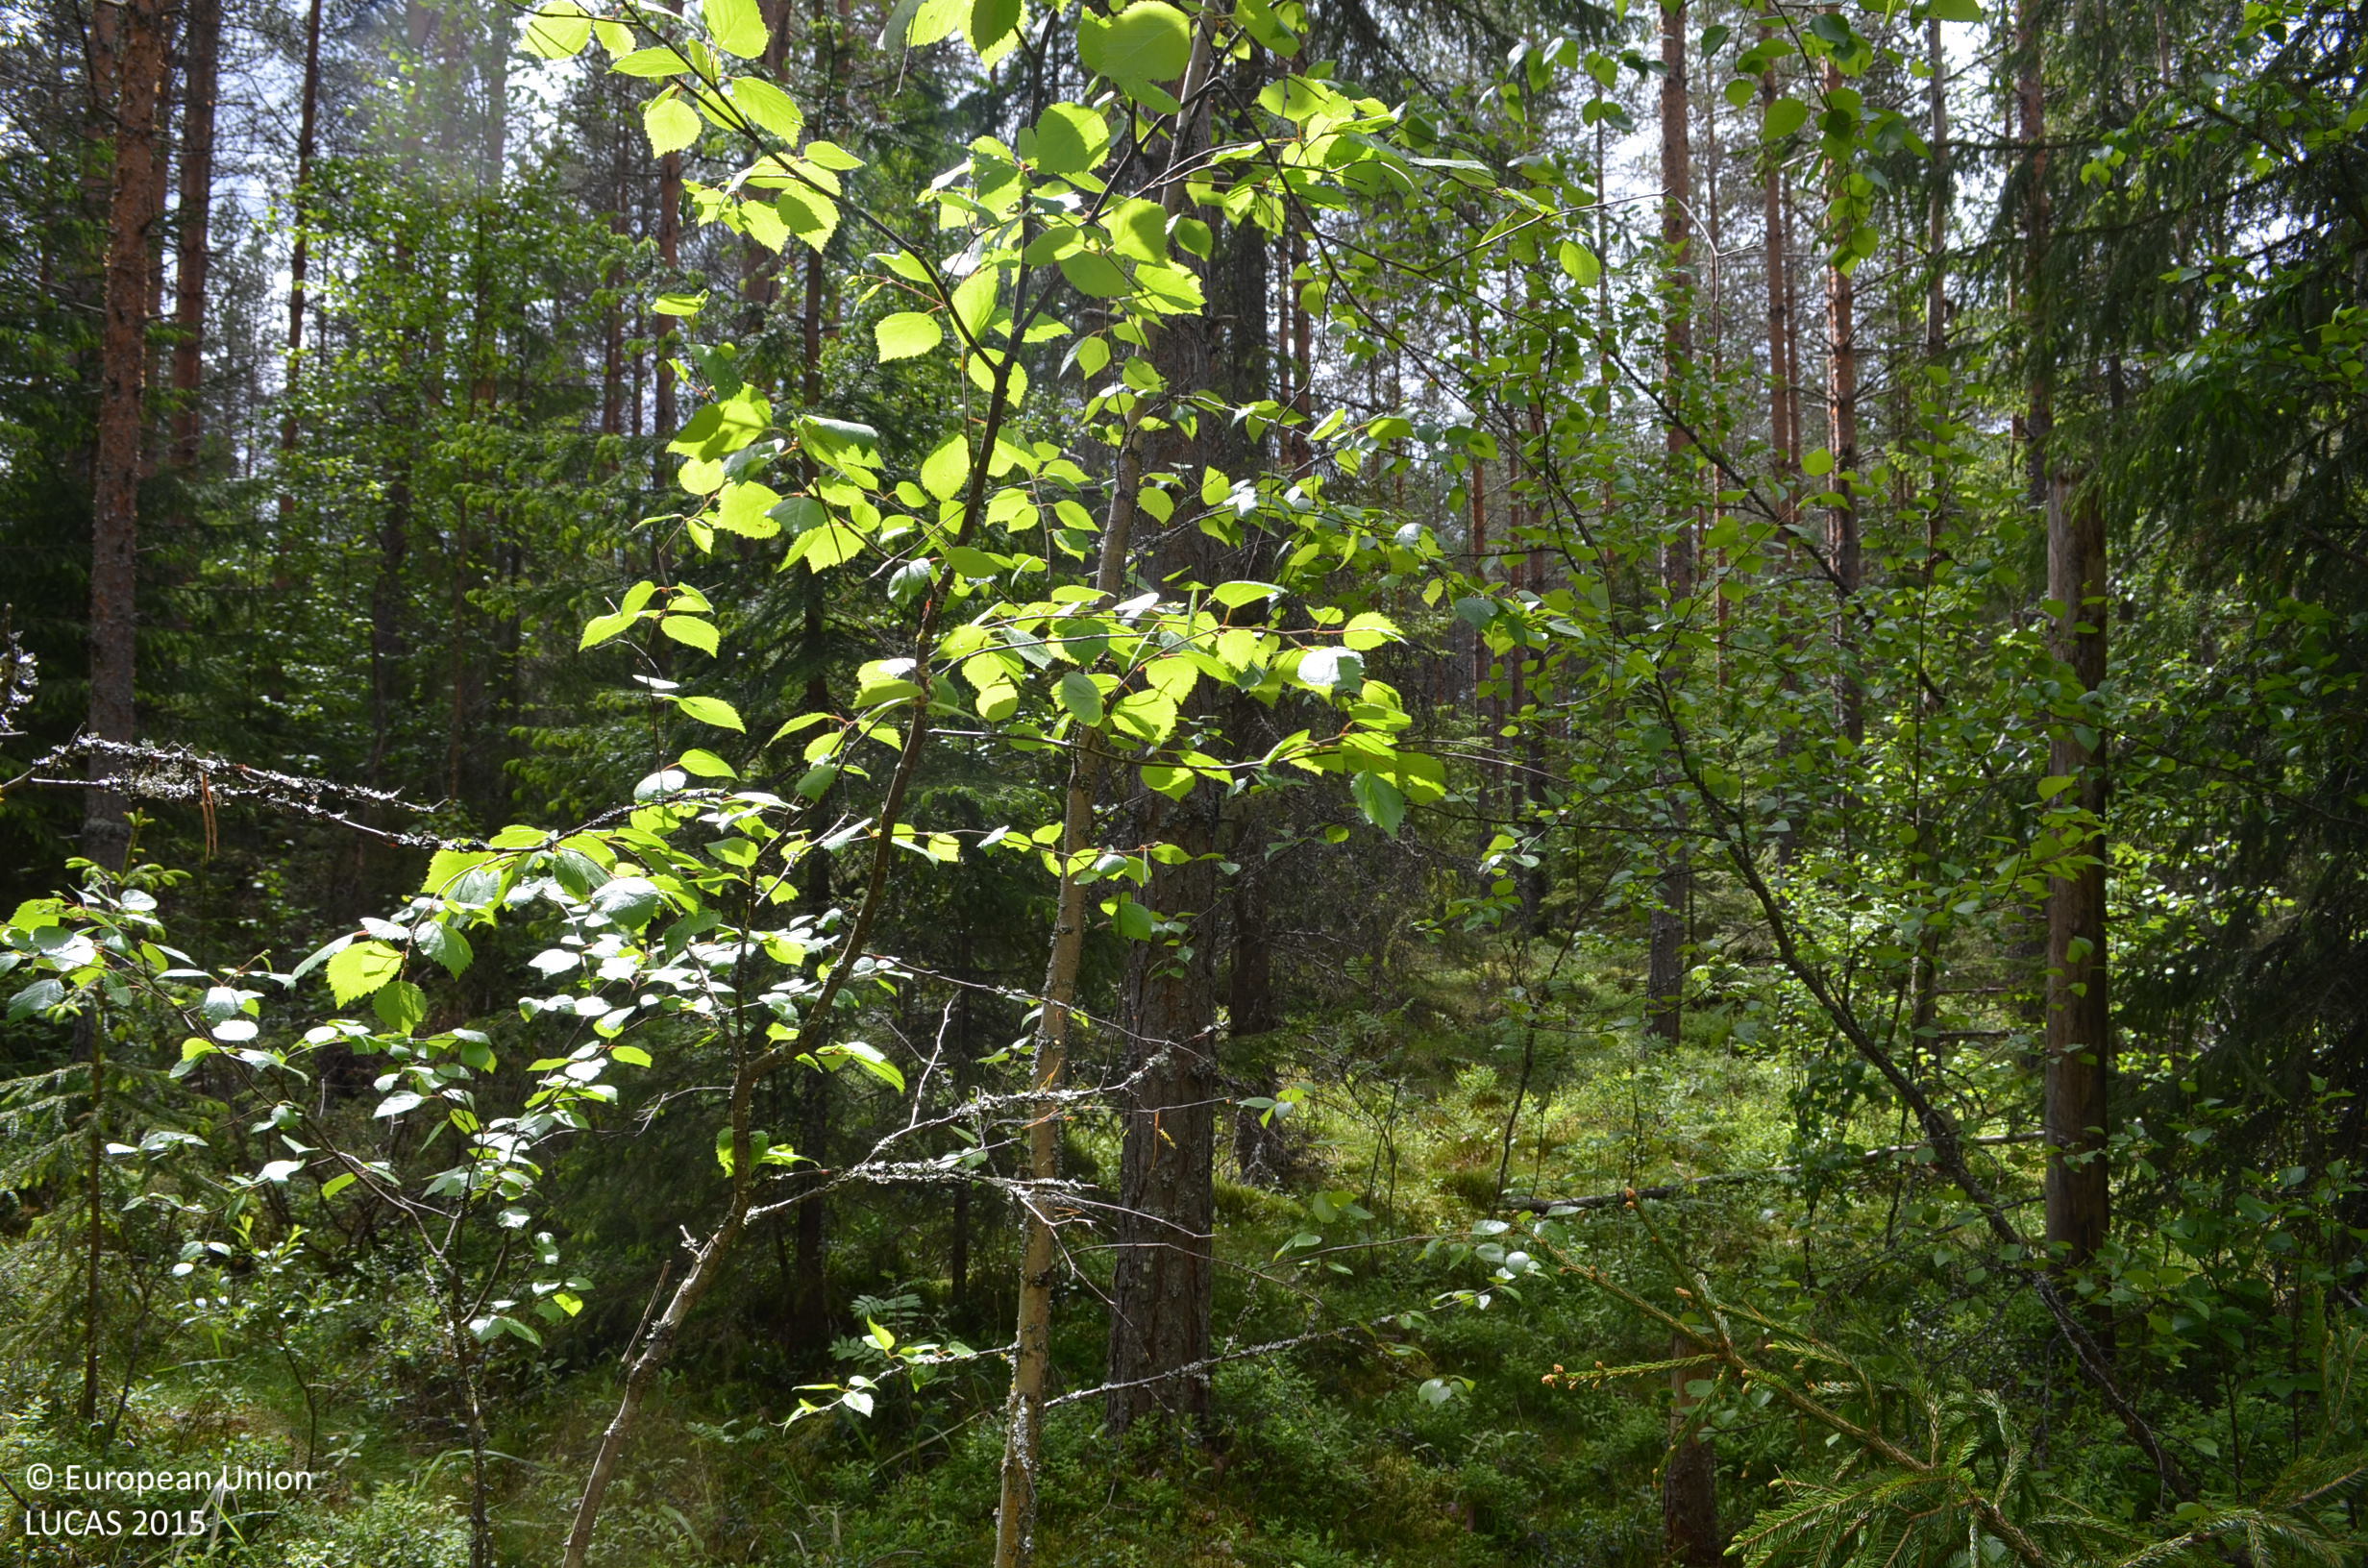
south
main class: Woodland
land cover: Other coniferous woodland
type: boreal forest
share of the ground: > 75 %
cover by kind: coniferous forest trees 75 %, herbaceous plants 20 %, broadleaved forest trees 5 %
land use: Forestry
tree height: > 5 m
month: June
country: FI
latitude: 62.0037
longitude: 23.2668
